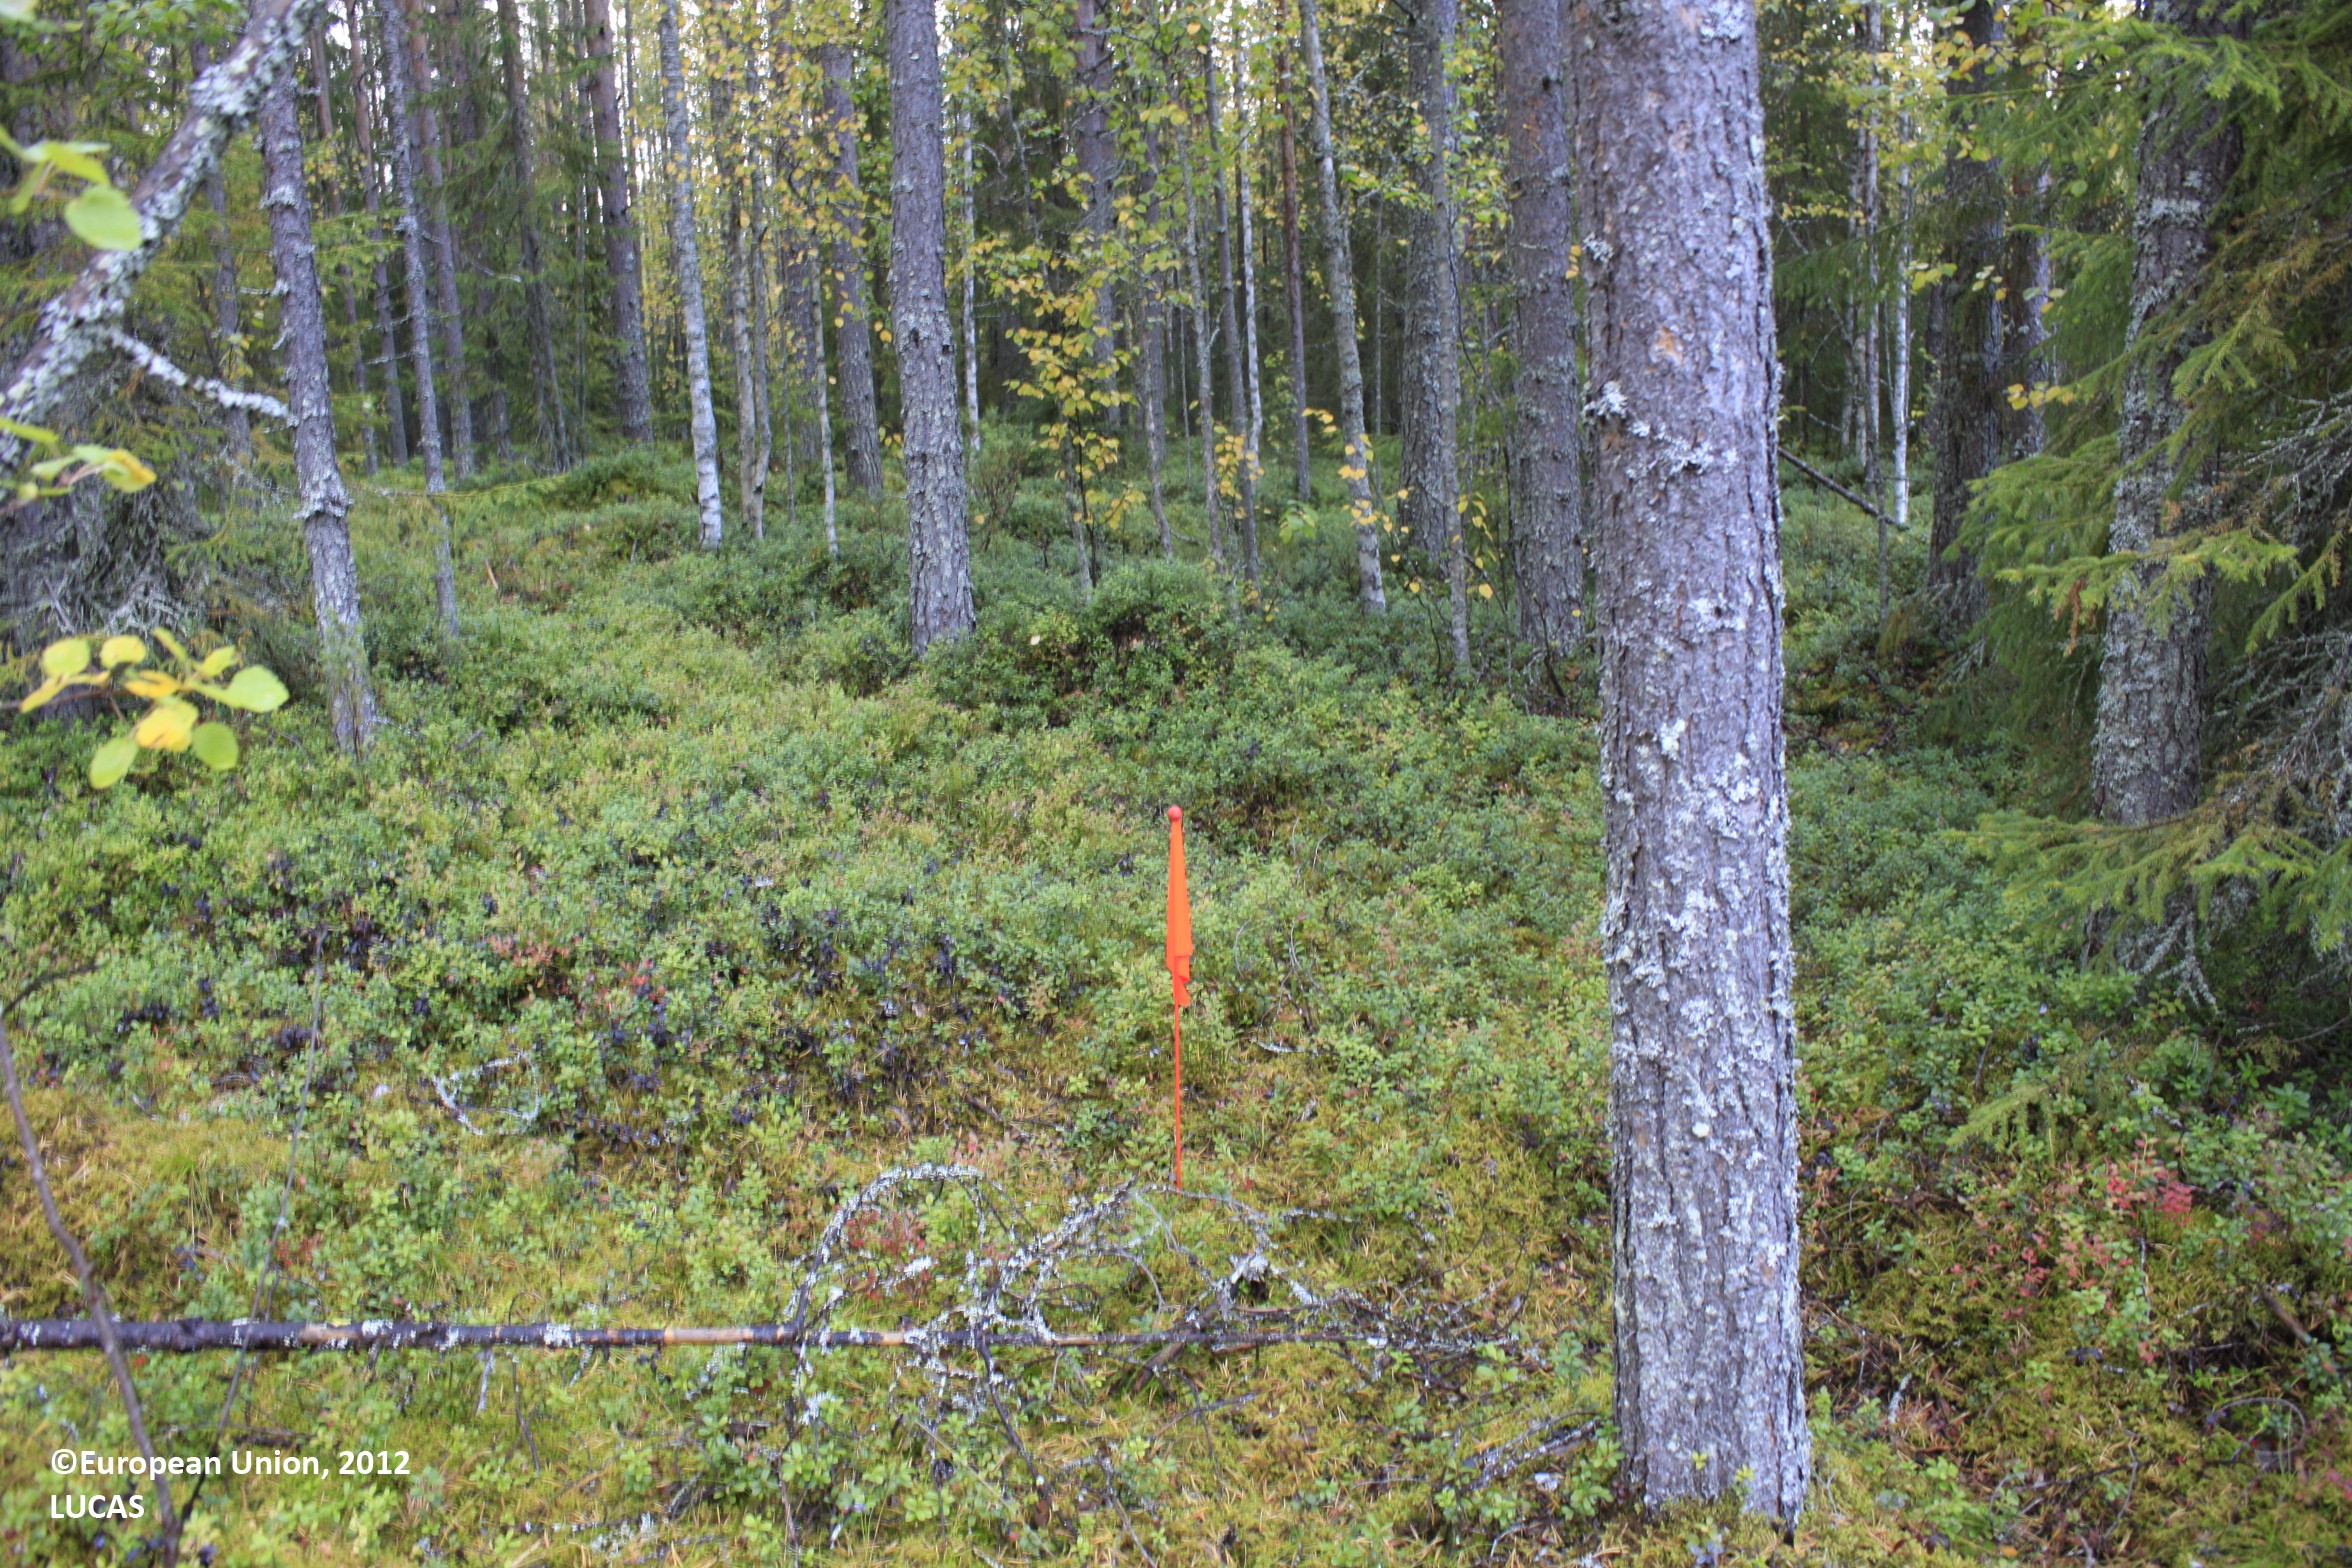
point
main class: Woodland
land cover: Pine dominated mixed woodland
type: boreal forest
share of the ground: 50 - 75 %
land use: Forestry
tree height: > 5 m
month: September
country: FI
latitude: 65.6977
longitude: 26.6747
